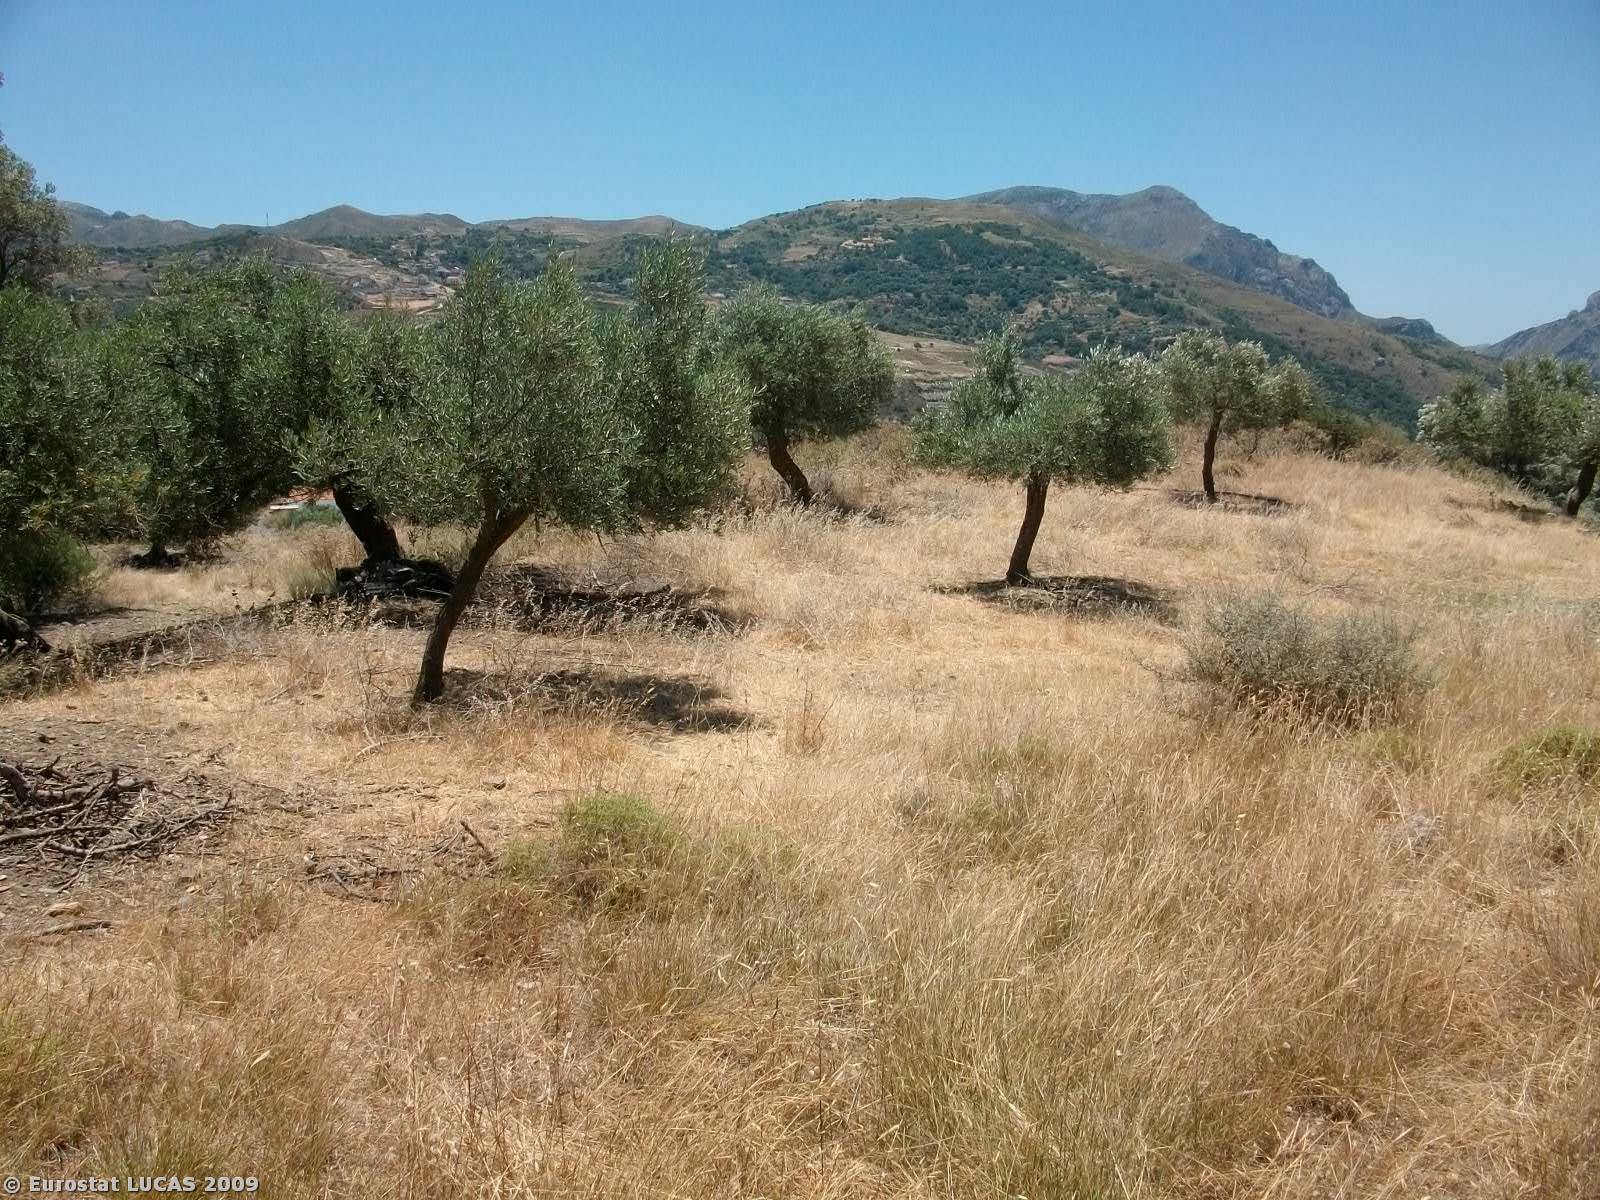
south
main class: Cropland
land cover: Olive groves
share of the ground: 25 - 50 %
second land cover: Grassland with sparse tree/shrub cover
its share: 50 - 75 %
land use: Agriculture (excluding fallow land and kitchen gardens)
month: June
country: GR
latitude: 35.2274
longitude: 24.5210
